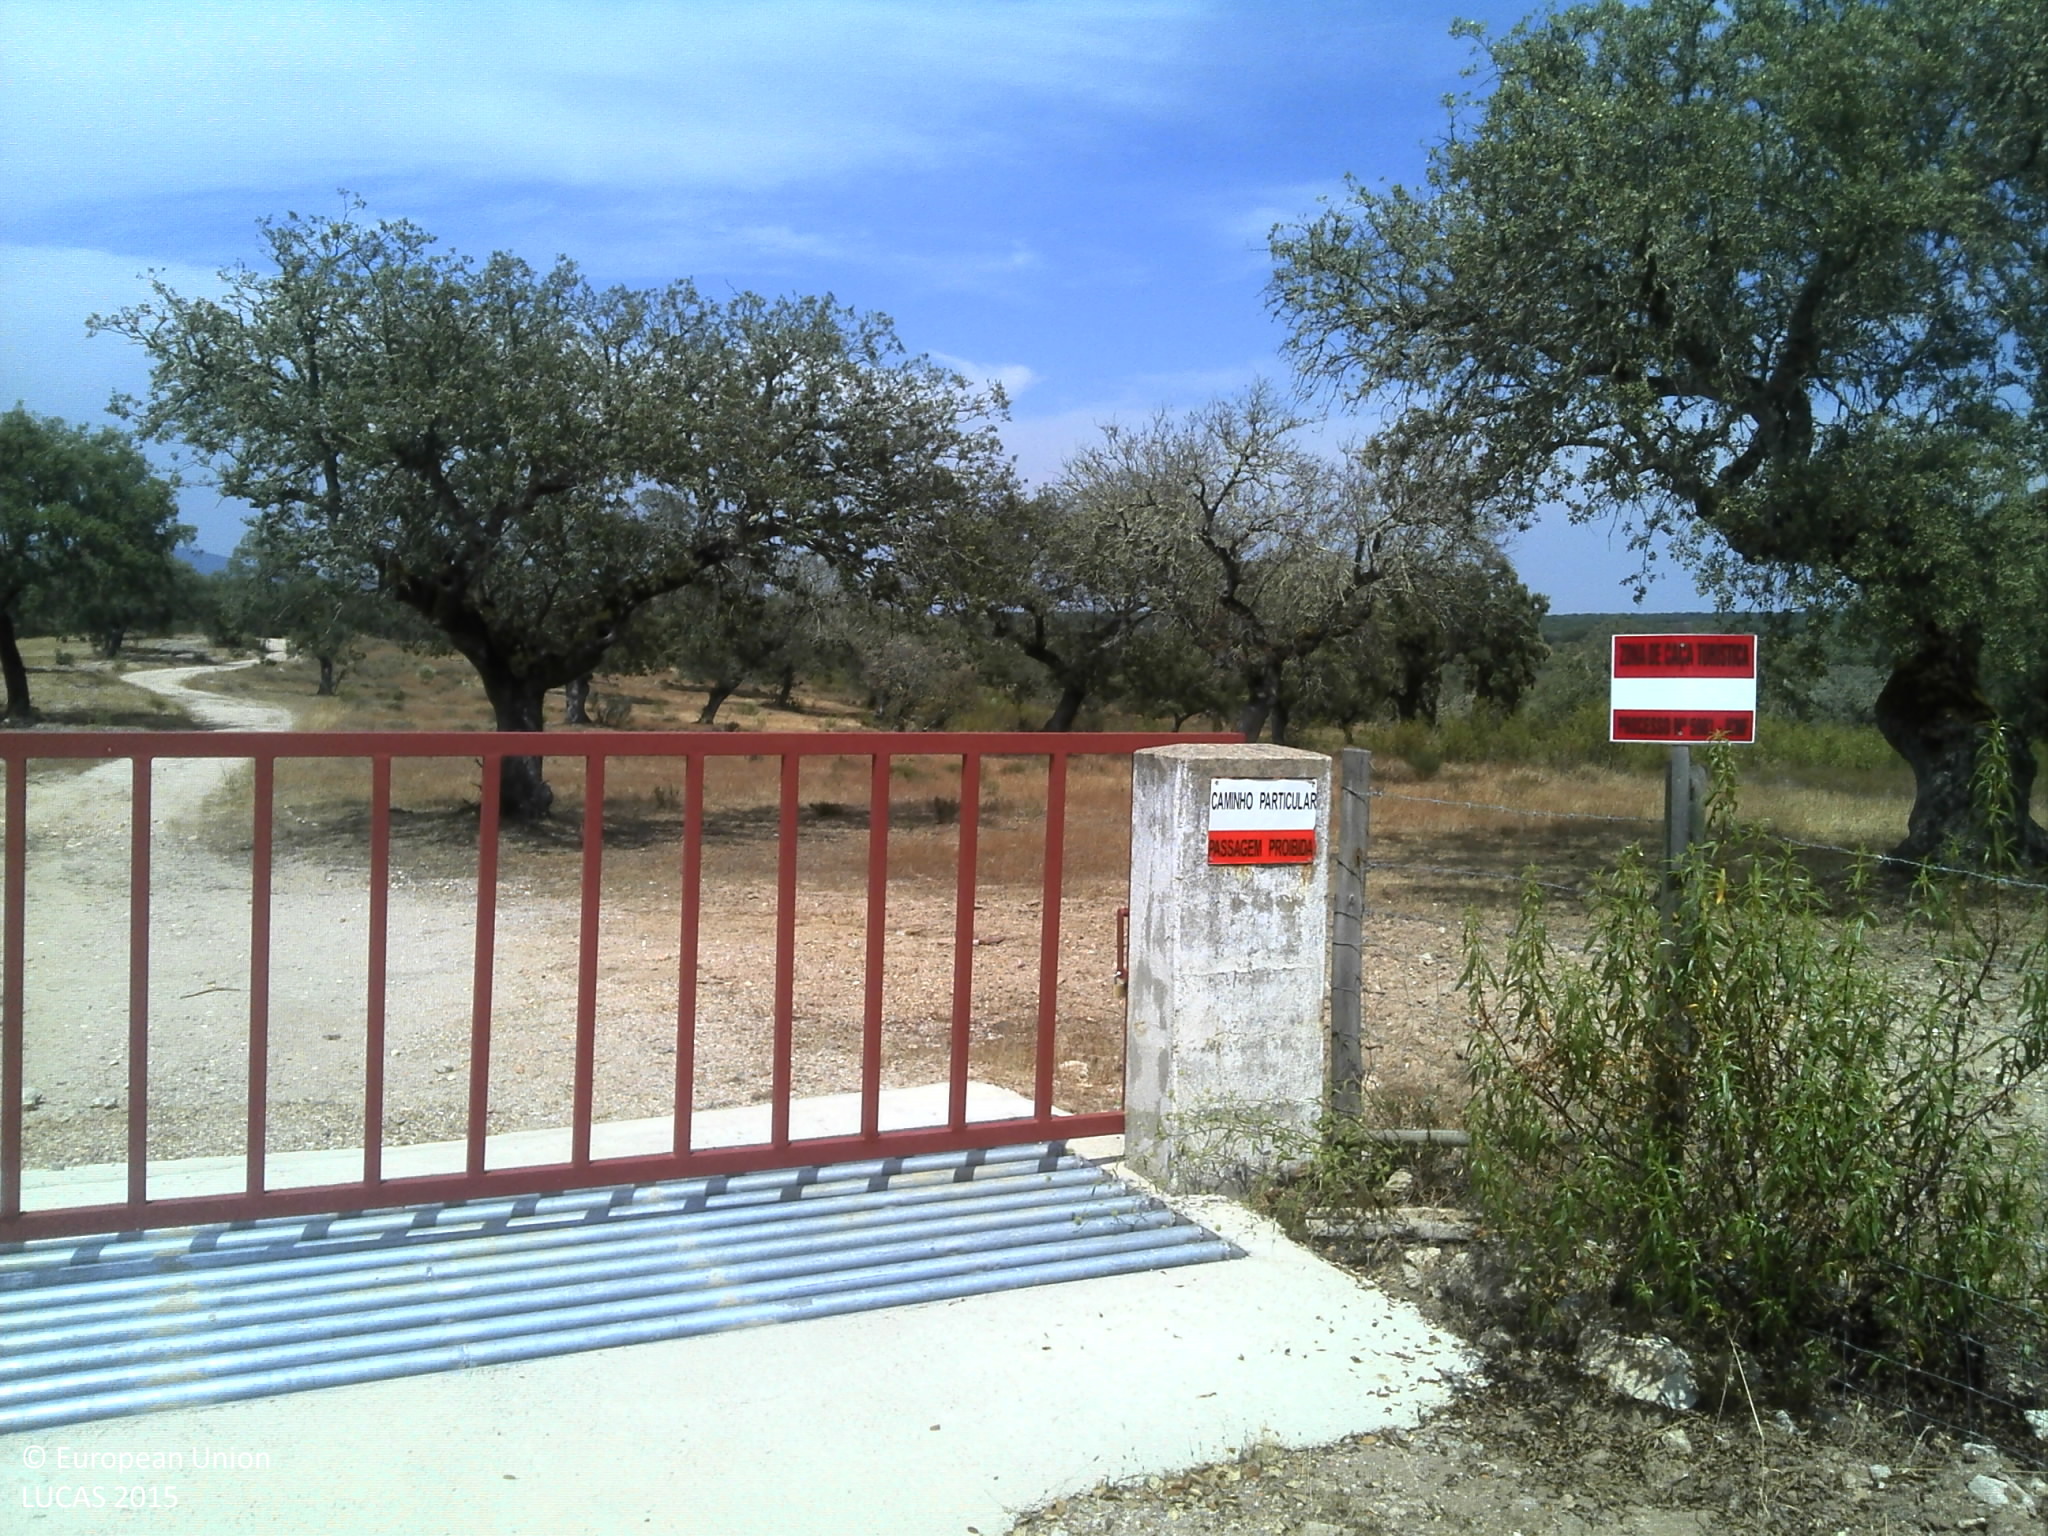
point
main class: Woodland
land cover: Broadleaved woodland
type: broadleaved evergreen forest
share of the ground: 25 - 50 %
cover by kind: broadleaved forest trees 40 %, herbaceous plants 40 %, unconsolidated bare surface 20 %
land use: Forestry
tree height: > 5 m
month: June
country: PT
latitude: 39.8941
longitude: -7.0119
